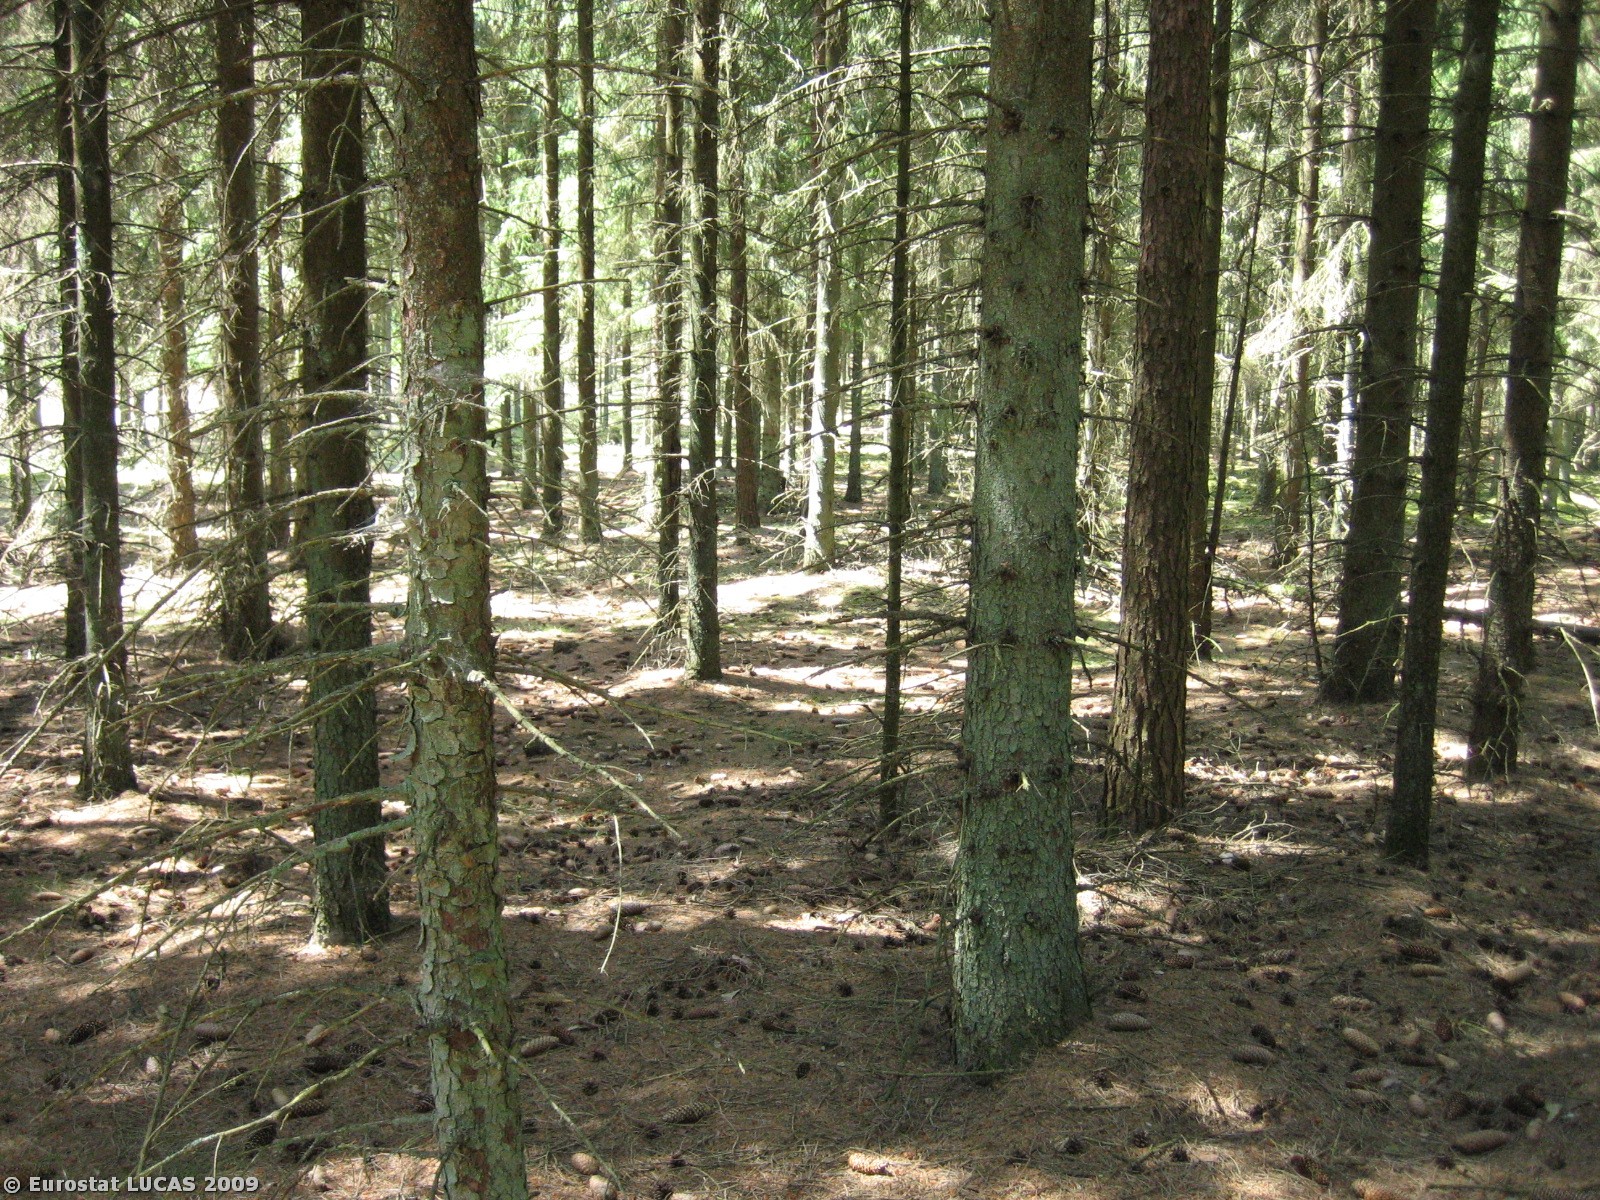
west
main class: Woodland
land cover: Coniferous woodland
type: hemiboreal forest and nemoral coniferous forest and mixed broadleaved-coniferous forest
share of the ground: > 75 %
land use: Forestry
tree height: > 5 m
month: July
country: DK
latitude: 55.6266
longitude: 9.0004
